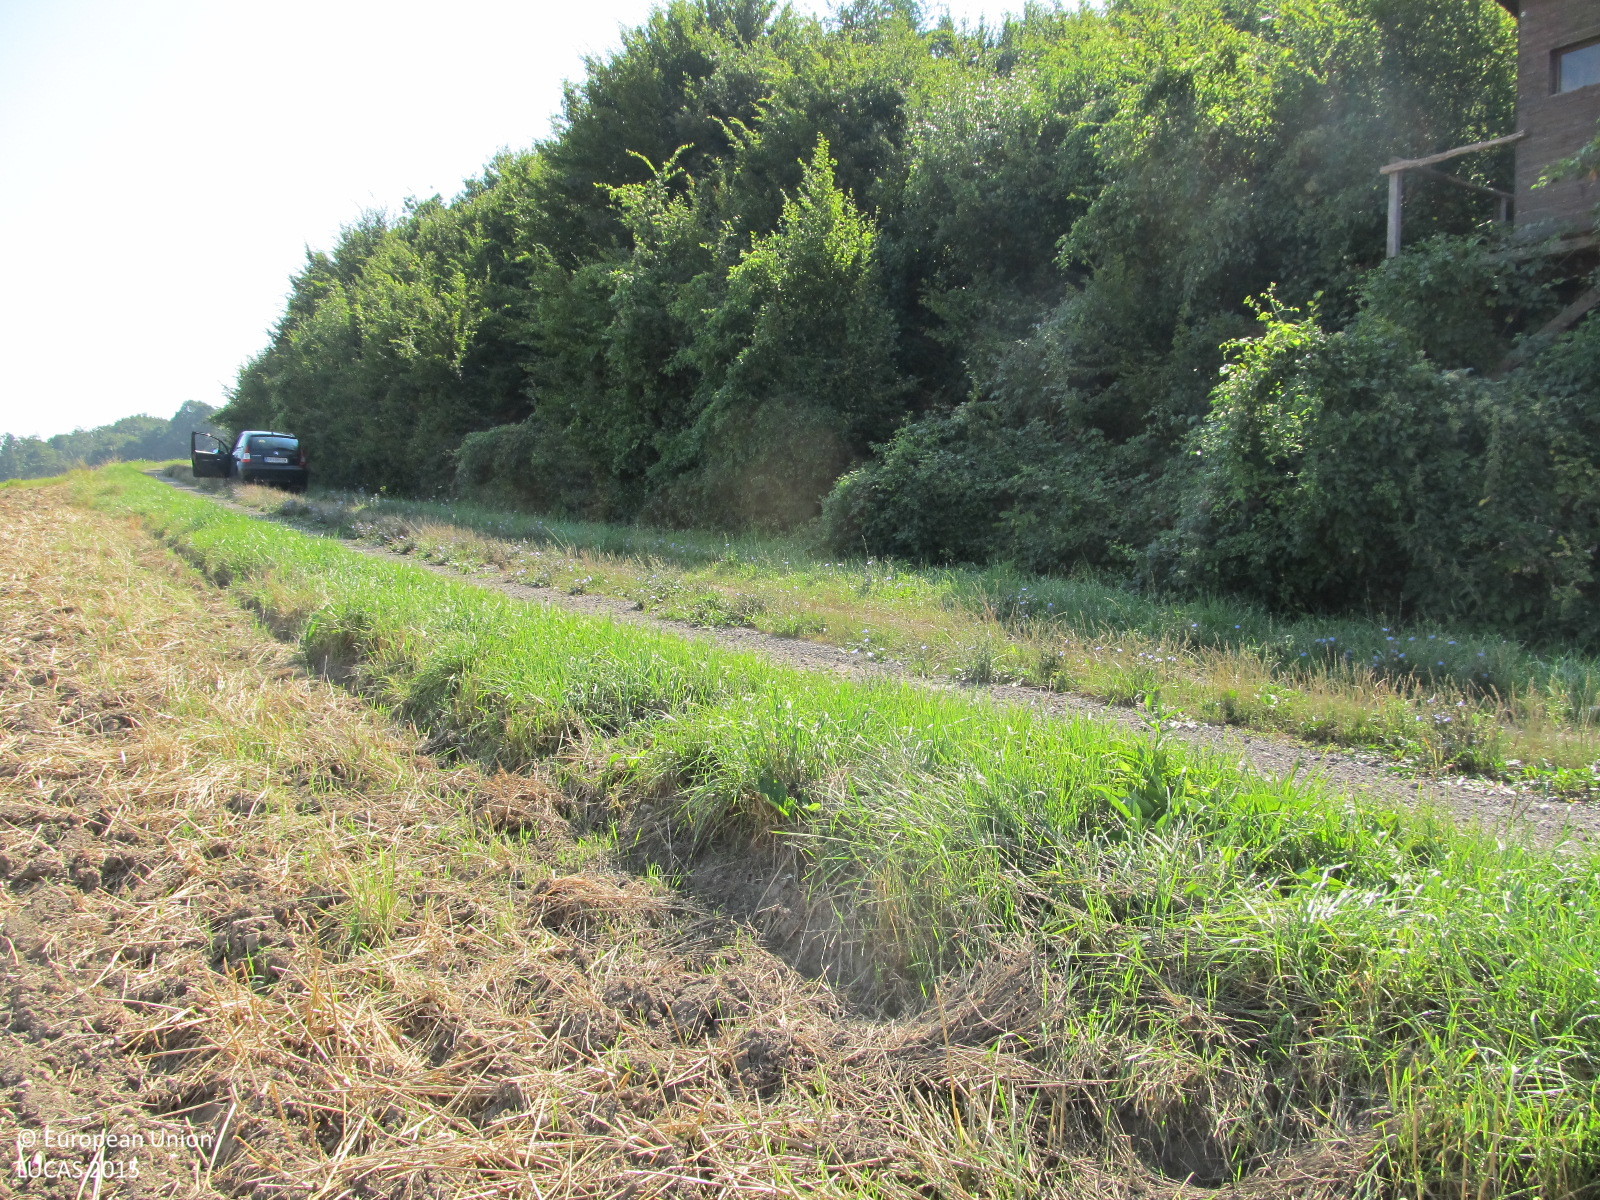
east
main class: Cropland
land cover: Common wheat
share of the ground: 10 - 25 %
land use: Agriculture (excluding fallow land and kitchen gardens)
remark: Harvested field
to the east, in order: Common wheat; Grass margins; Tracks; Grass margins; Spruce dominated mixed woodland; Broadleaved woodland; Rivers and streams; Broadleaved woodland
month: August
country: AT
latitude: 48.1805
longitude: 15.7728
